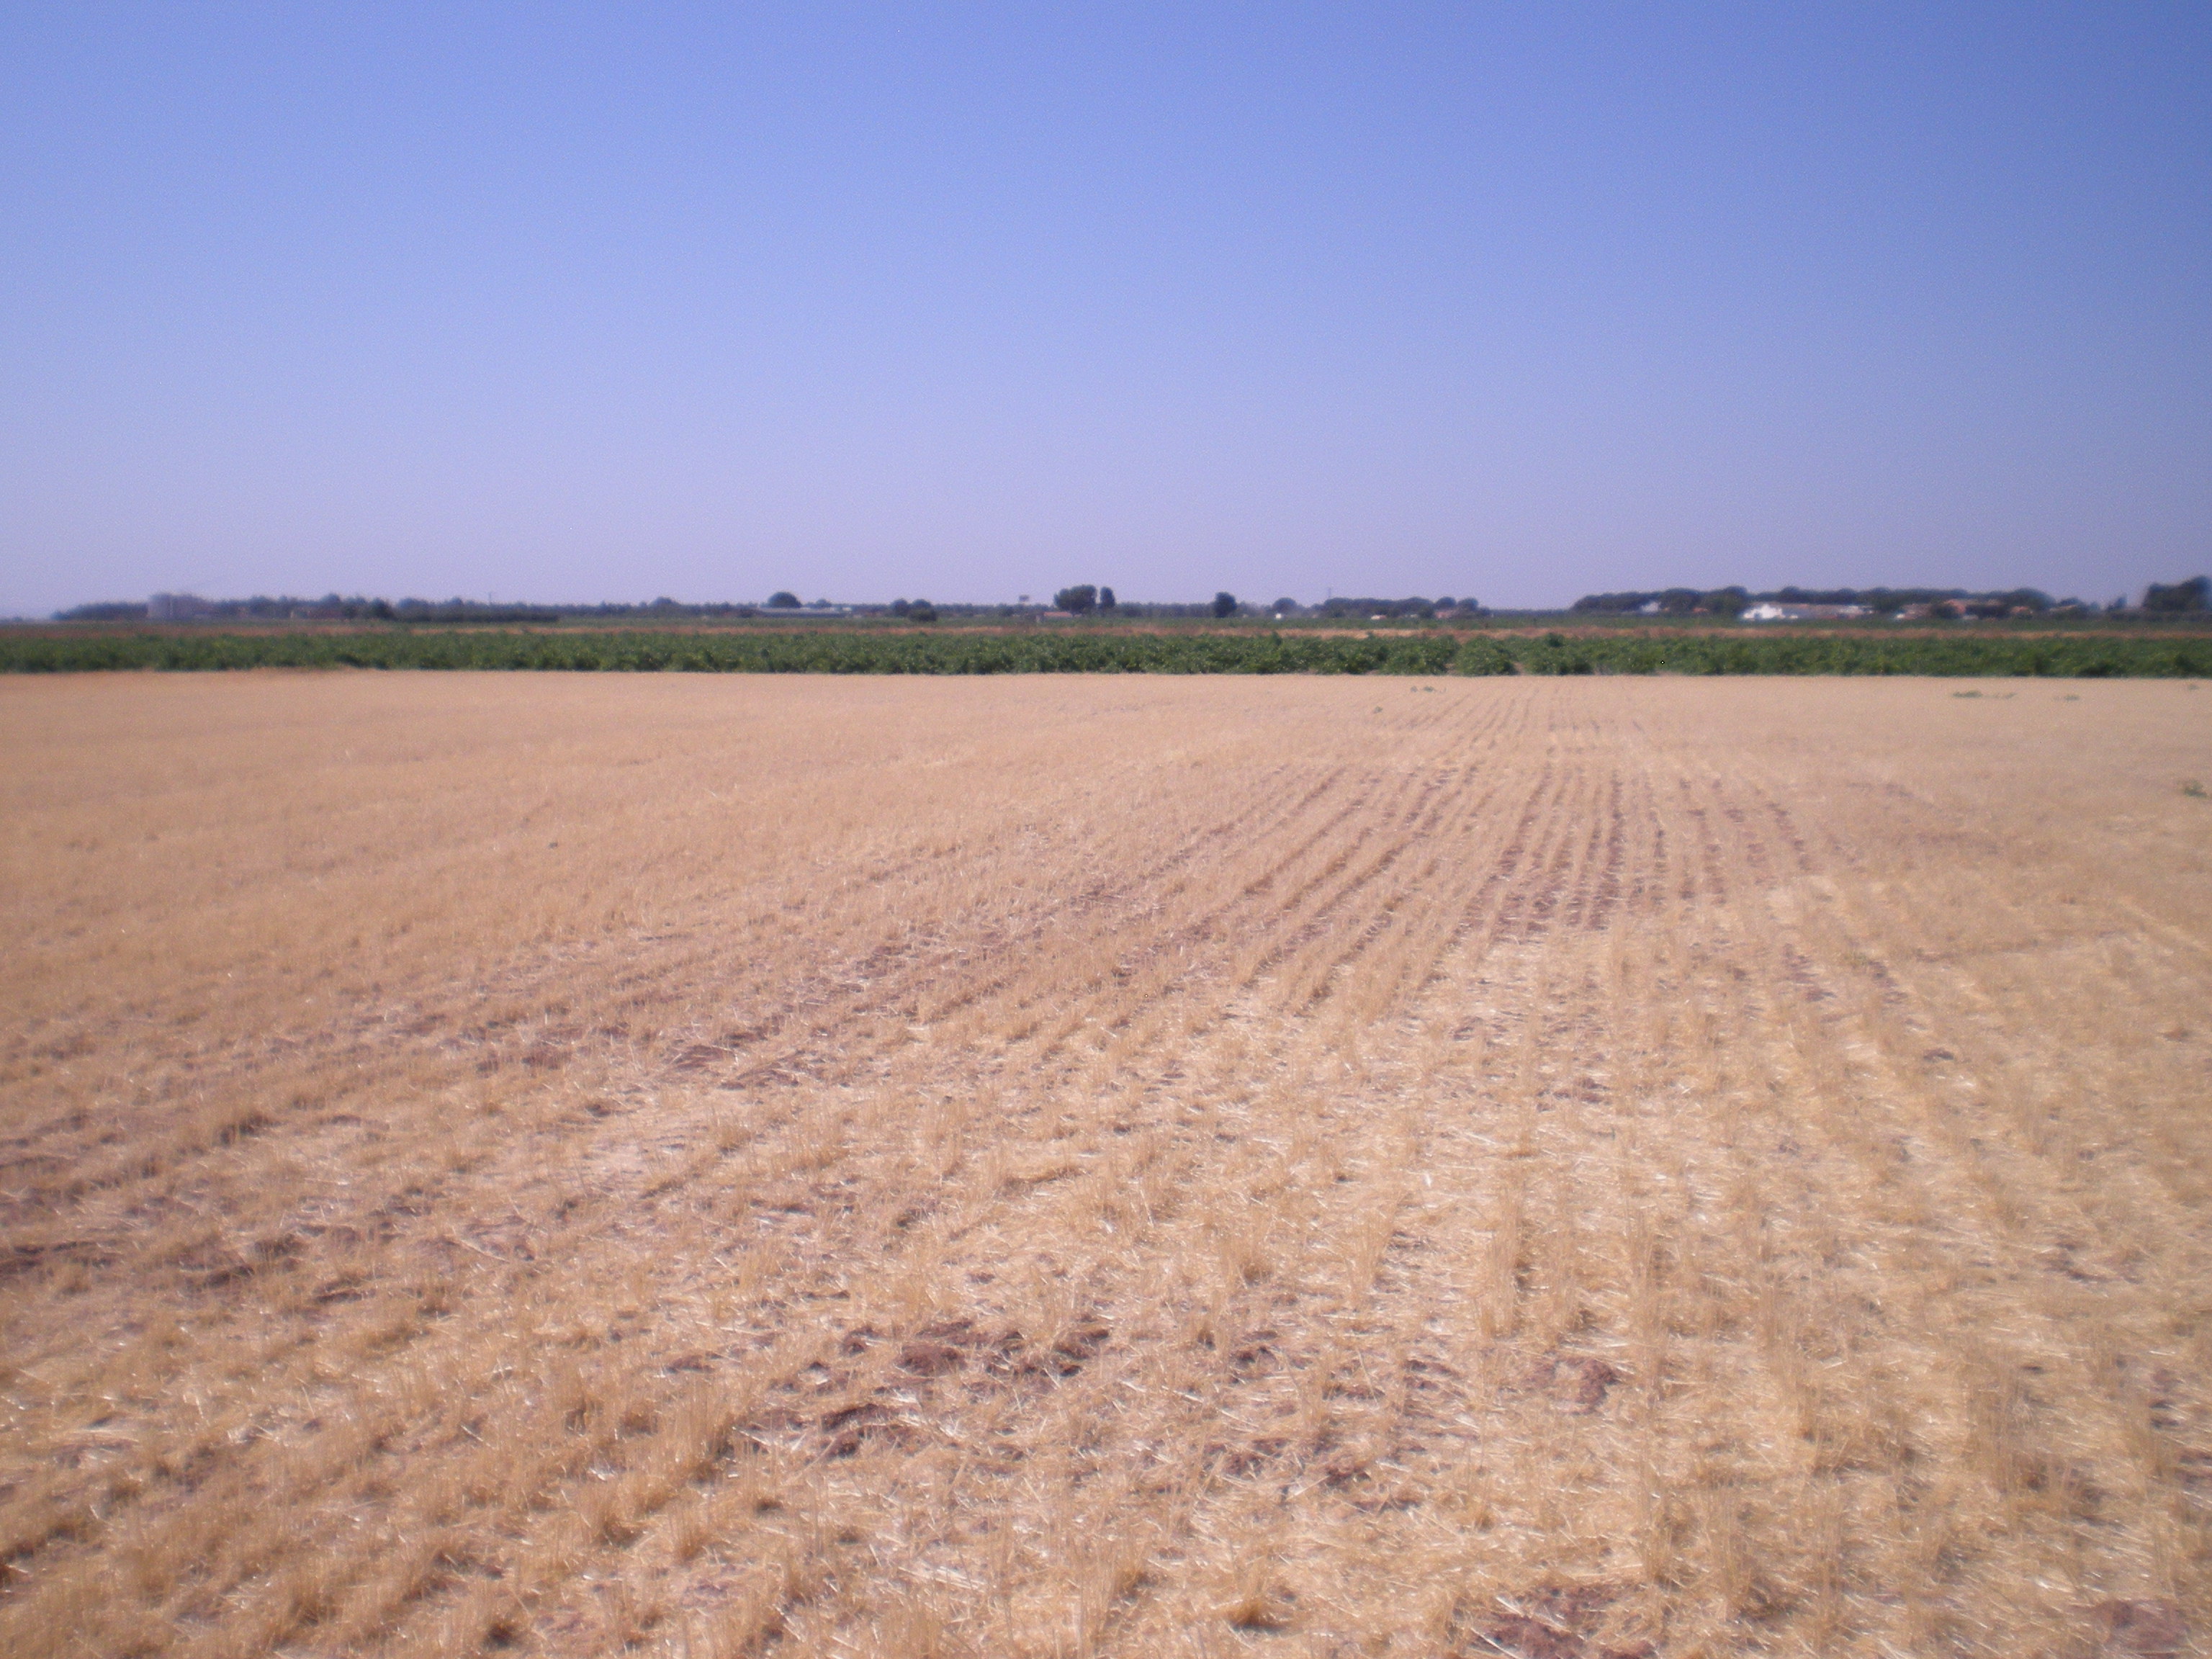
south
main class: Cropland
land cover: Barley
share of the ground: < 10 %
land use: Agriculture (excluding fallow land and kitchen gardens)
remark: Harvested field
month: July
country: ES
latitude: 39.3227
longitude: -3.0180
